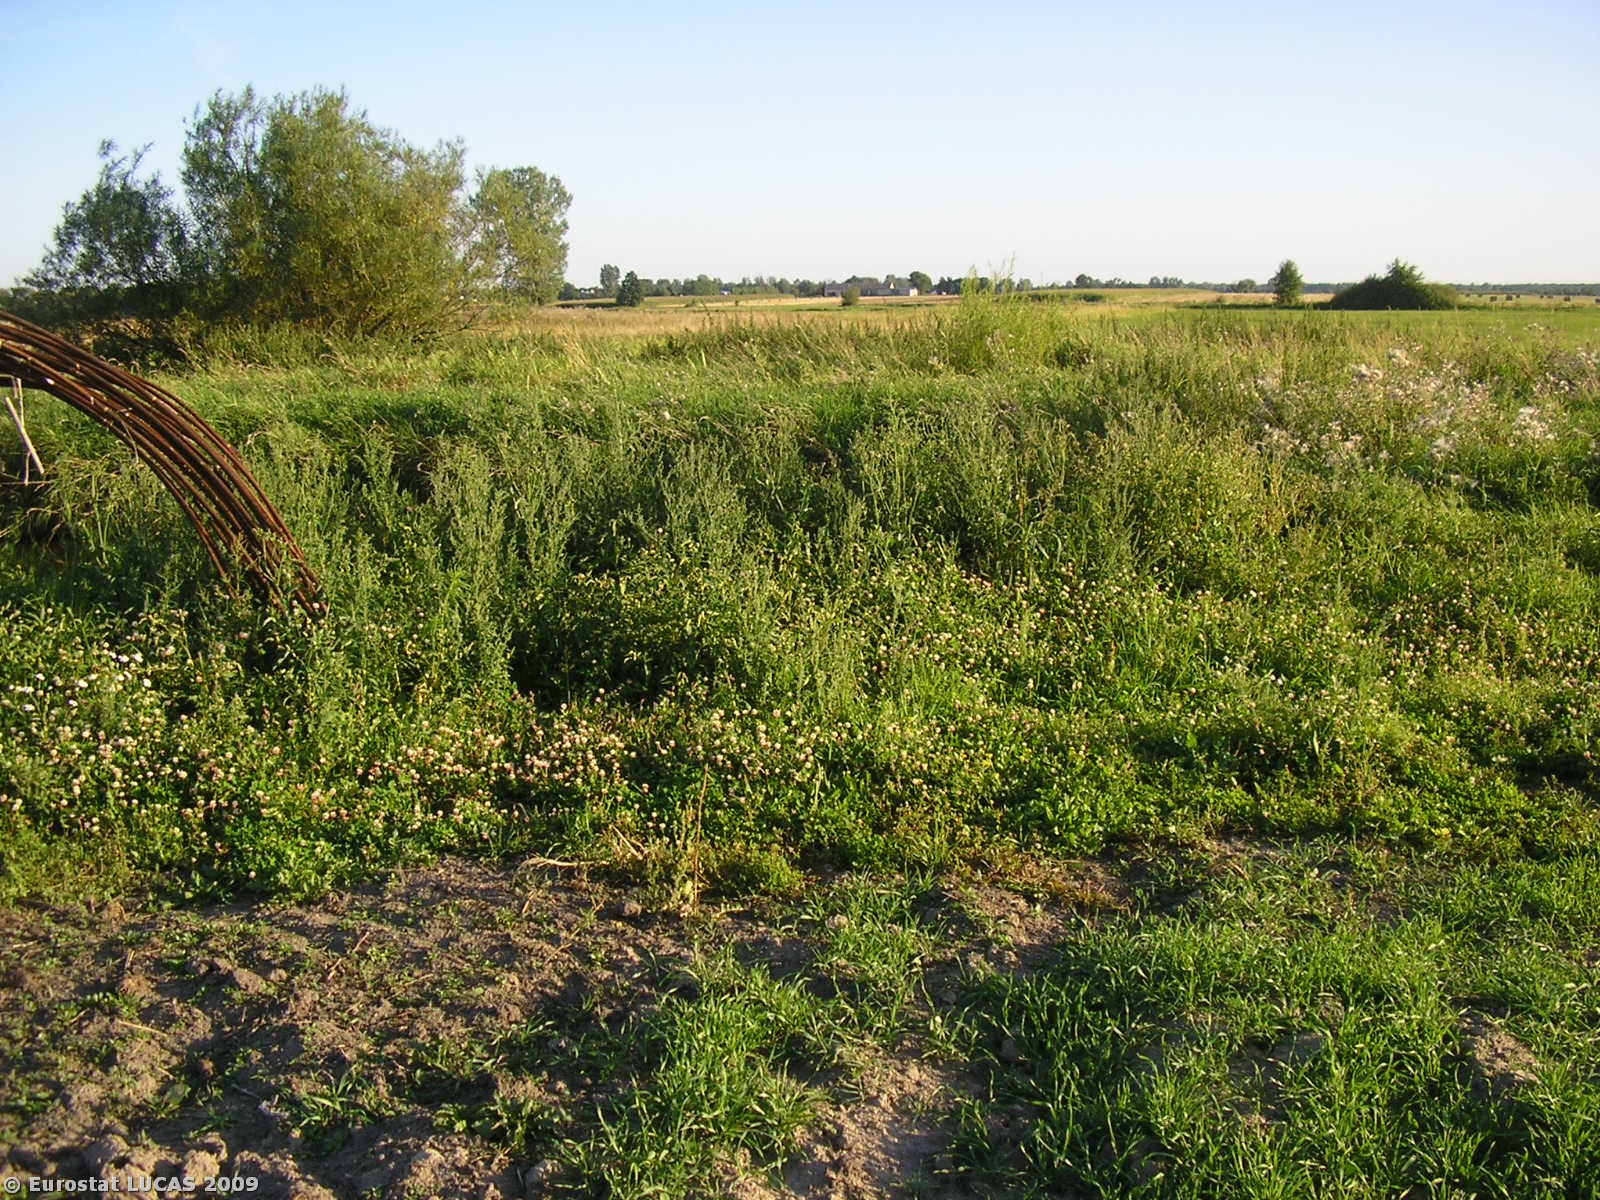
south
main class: Grassland
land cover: Grassland without tree/shrub cover
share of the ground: > 75 %
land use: Agriculture (excluding fallow land and kitchen gardens)
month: August
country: PL
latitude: 52.0507
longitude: 19.4916
